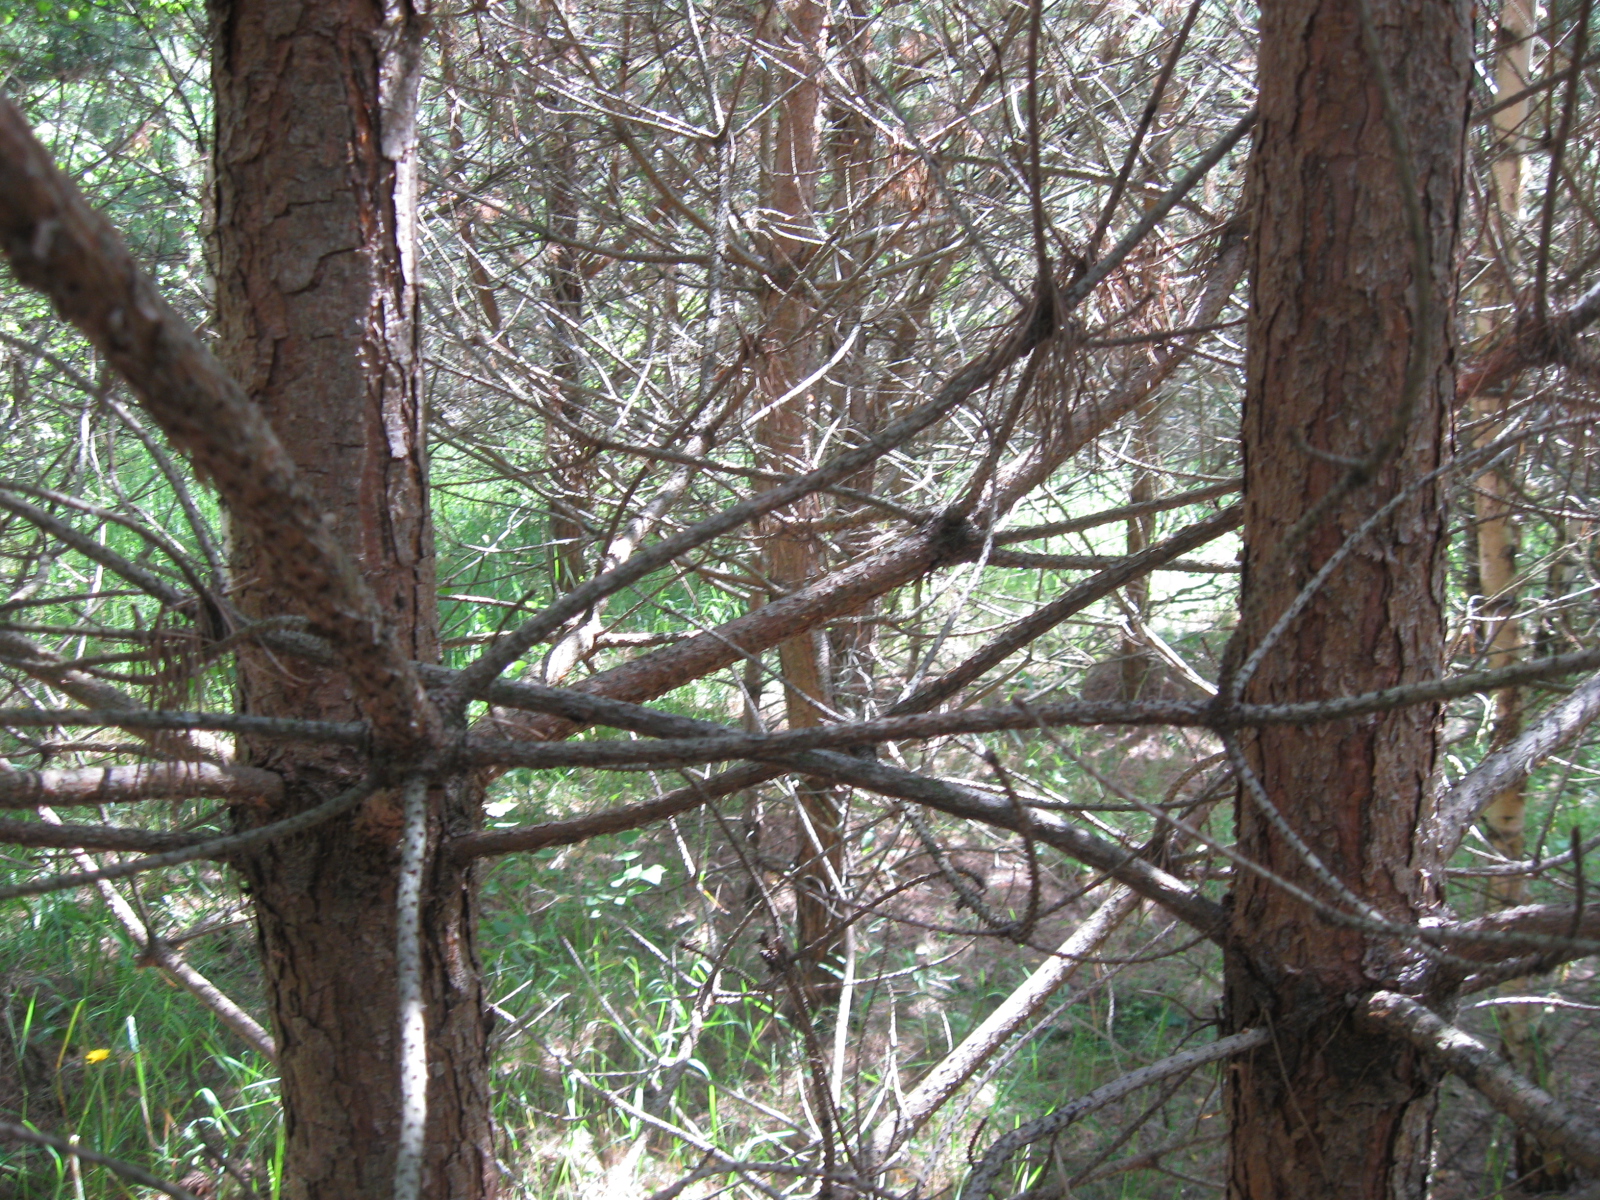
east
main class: Woodland
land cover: Pine dominated coniferous woodland
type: hemiboreal forest and nemoral coniferous forest and mixed broadleaved-coniferous forest
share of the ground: > 75 %
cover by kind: coniferous forest trees 95 %, herbaceous plants 5 %
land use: Forestry
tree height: < 5 m
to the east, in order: Pine dominated coniferous woodland; Spontaneously vegetated surfaces; Pine dominated coniferous woodland
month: July
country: LT
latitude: 54.3632
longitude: 24.5558
